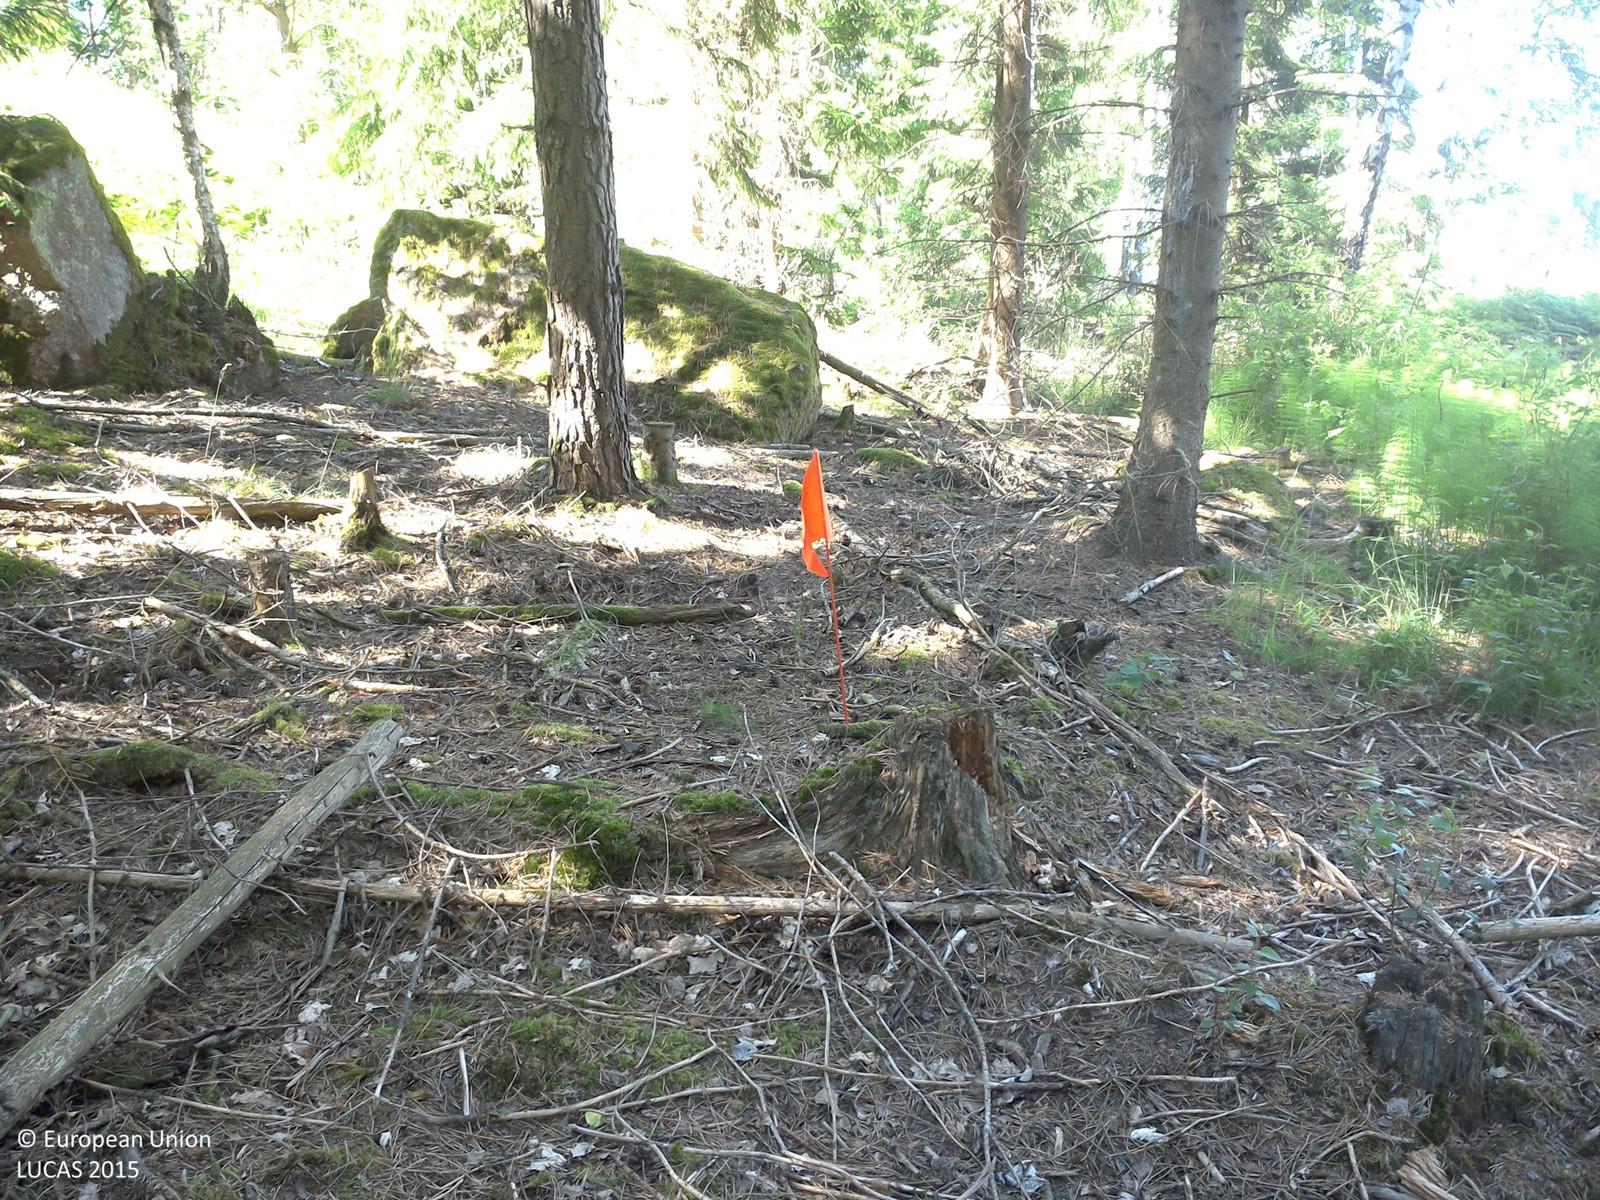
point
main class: Woodland
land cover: Spruce dominated coniferous woodland
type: boreal forest
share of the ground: > 75 %
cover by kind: coniferous forest trees 75 %, lichens and mosses 20 %, herbaceous plants 5 %
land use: Forestry
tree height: > 5 m
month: July
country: SE
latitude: 58.3451
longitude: 15.4101
